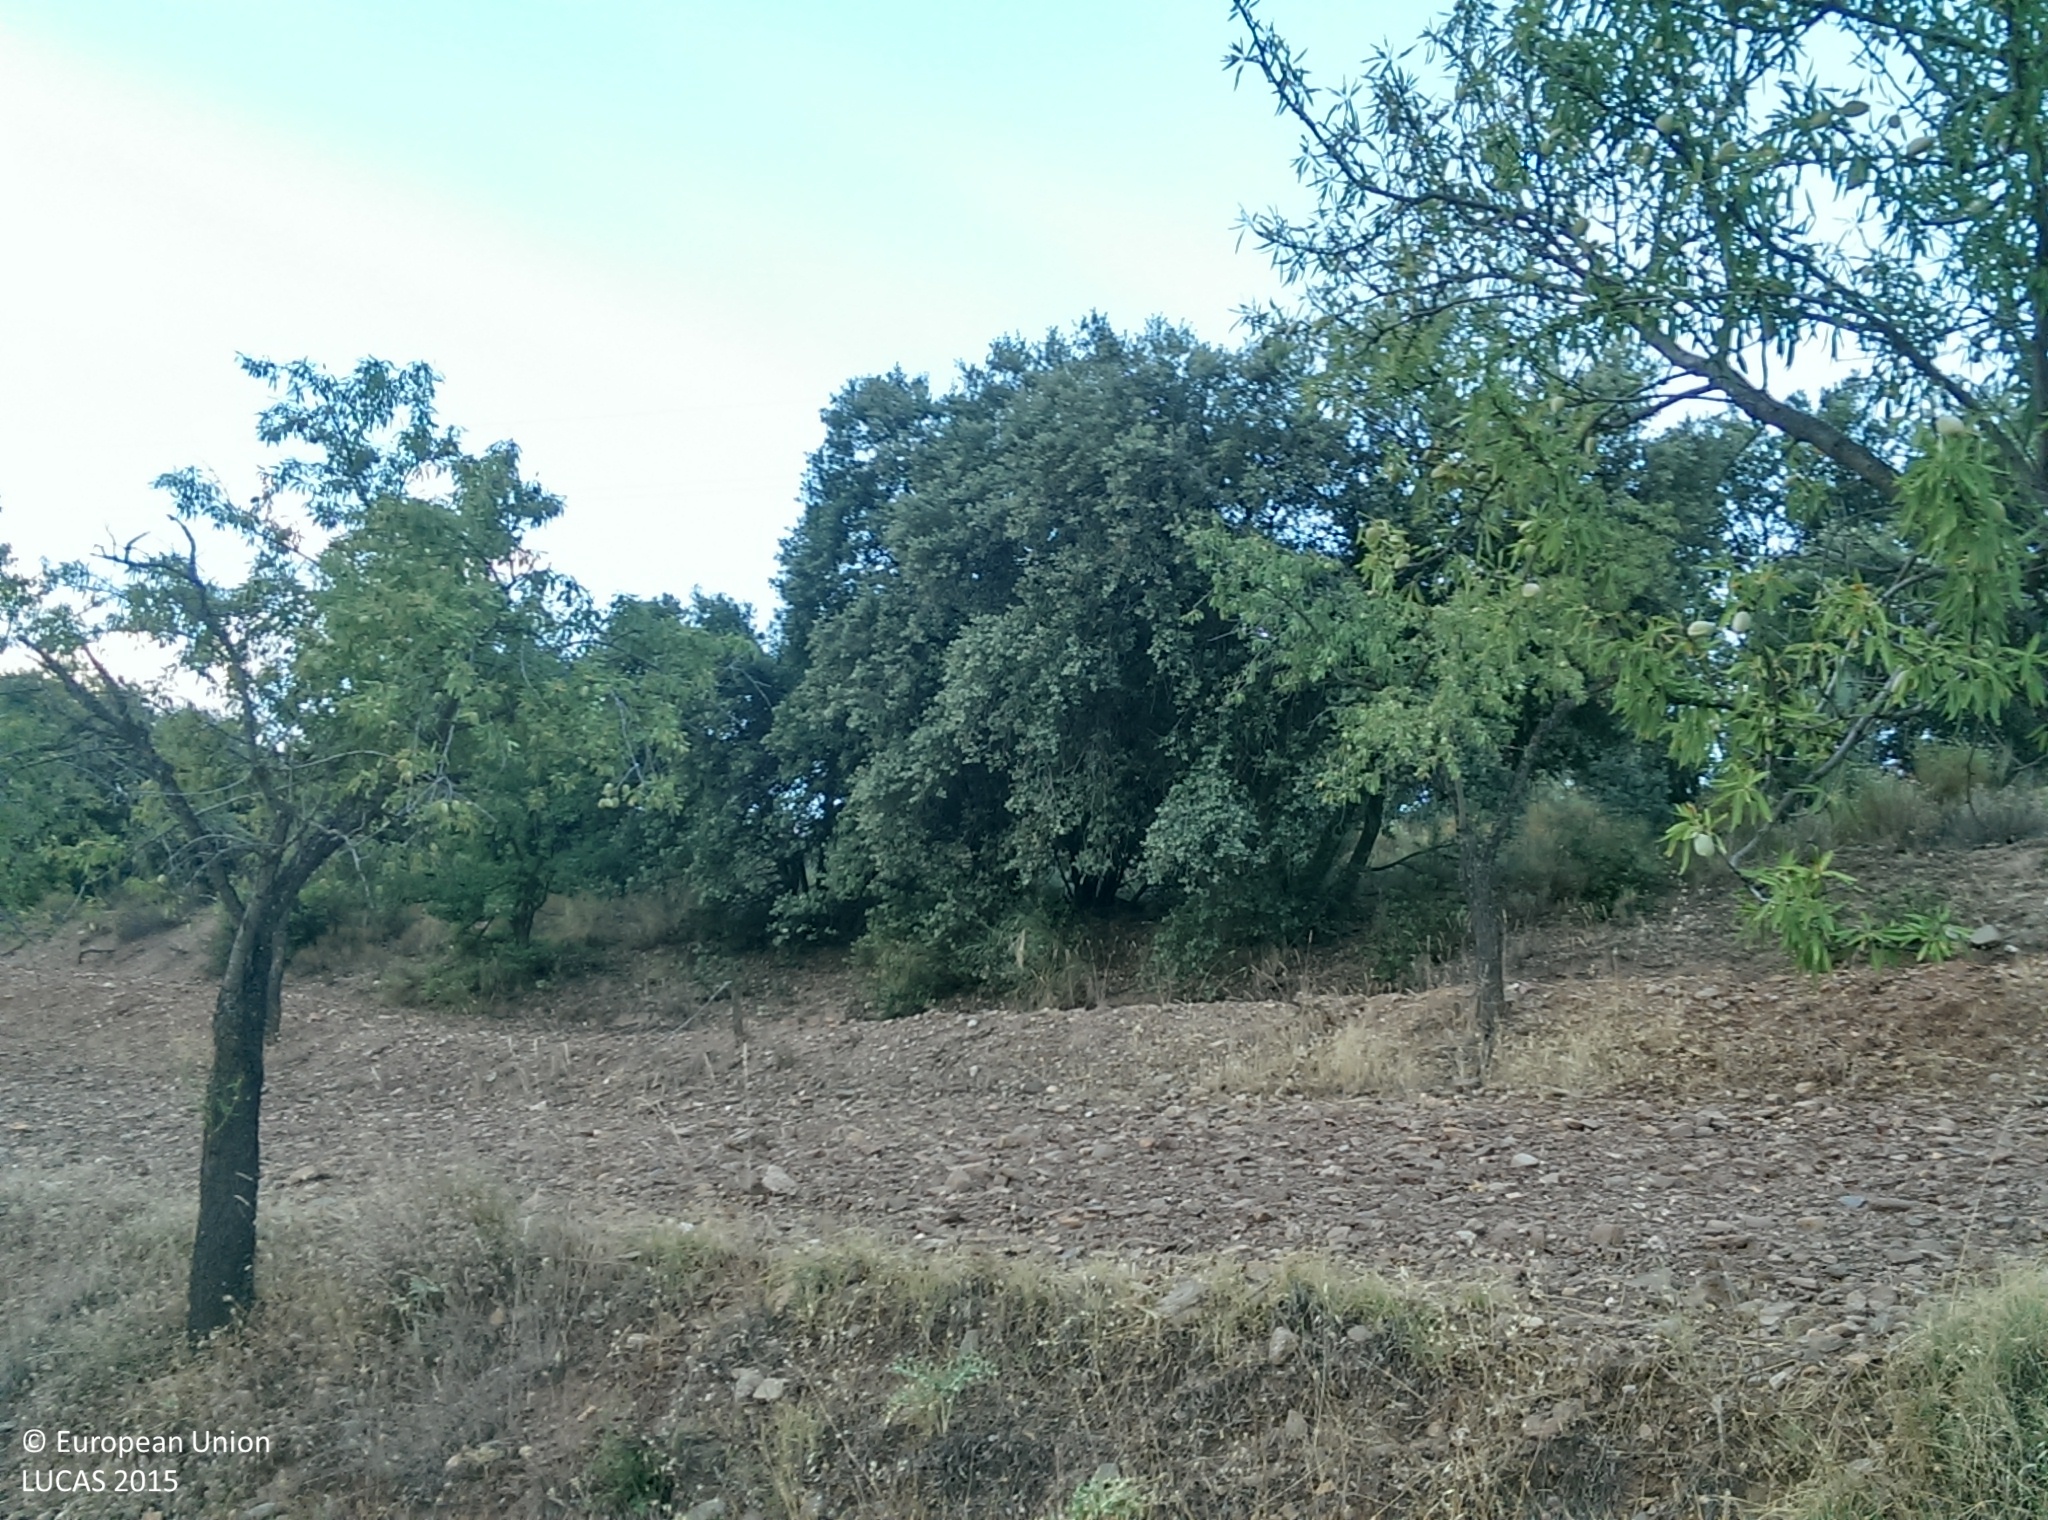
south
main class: Cropland
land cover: Nuts trees
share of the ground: 25 - 50 %
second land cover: Other bare soil
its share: > 75 %
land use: Agriculture (excluding fallow land and kitchen gardens)
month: July
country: ES
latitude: 37.2731
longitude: -3.2613
